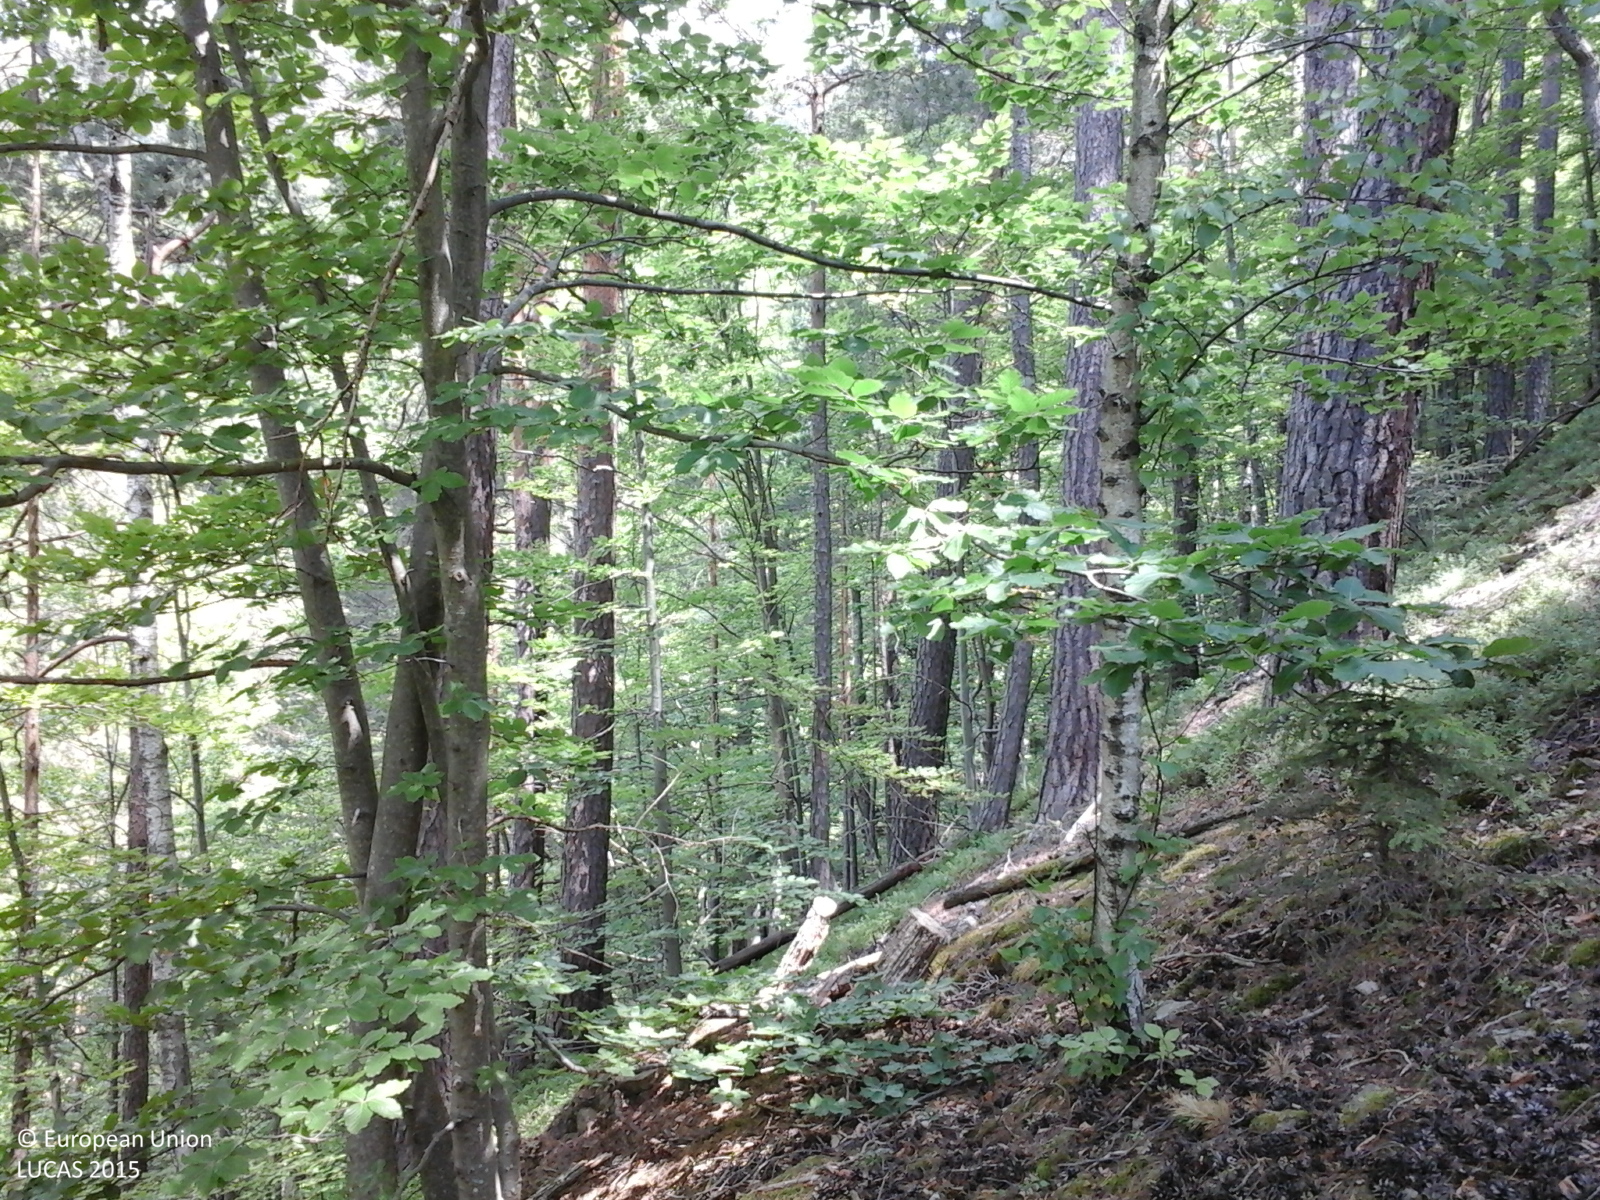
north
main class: Woodland
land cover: Pine dominated mixed woodland
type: alpine coniferous forest
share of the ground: > 75 %
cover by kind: coniferous forest trees 75 %, broadleaved forest trees 25 %
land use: Forestry
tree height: > 5 m
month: June
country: RO
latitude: 46.2620
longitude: 26.4386
